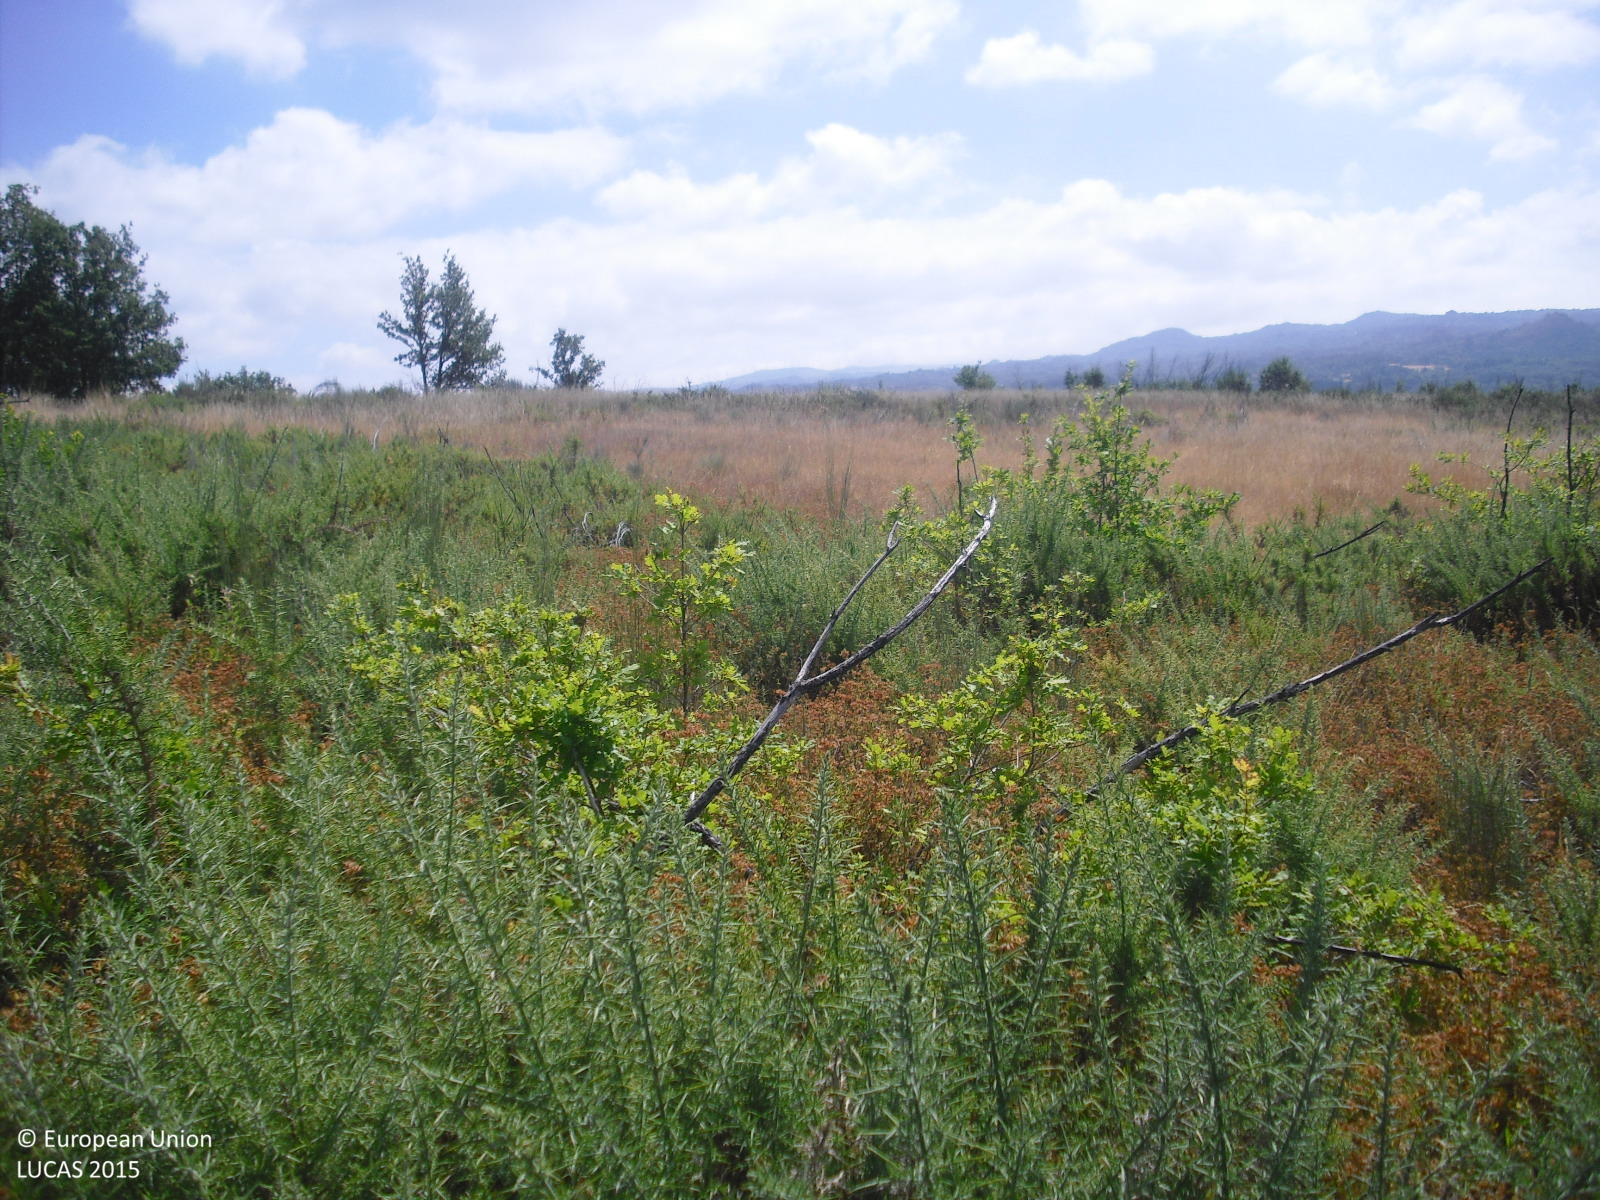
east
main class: Shrubland
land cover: Shrubland with sparse tree cover
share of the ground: > 75 %
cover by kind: shrubs 80 %, herbaceous plants 15 %, broadleaved forest trees 5 %
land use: Abandoned areas
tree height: < 5 m
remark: Burnt area
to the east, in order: Shrubland with sparse tree cover; Grassland without tree/shrub cover; Grassland with sparse tree/shrub cover; Shrubland with sparse tree cover; Ditches and canals; Paved roads, cycling and walking lanes; Ditches and canals; Grassland with sparse tree/shrub cover; Tracks; Fences; Grassland with sparse tree/shrub cover; Shrubland with sparse tree cover; Single bushes/trees; Shrubland without tree cover; Shrubland with sparse tree cover; Tracks
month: July
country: ES
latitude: 42.3600
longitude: -7.7647
